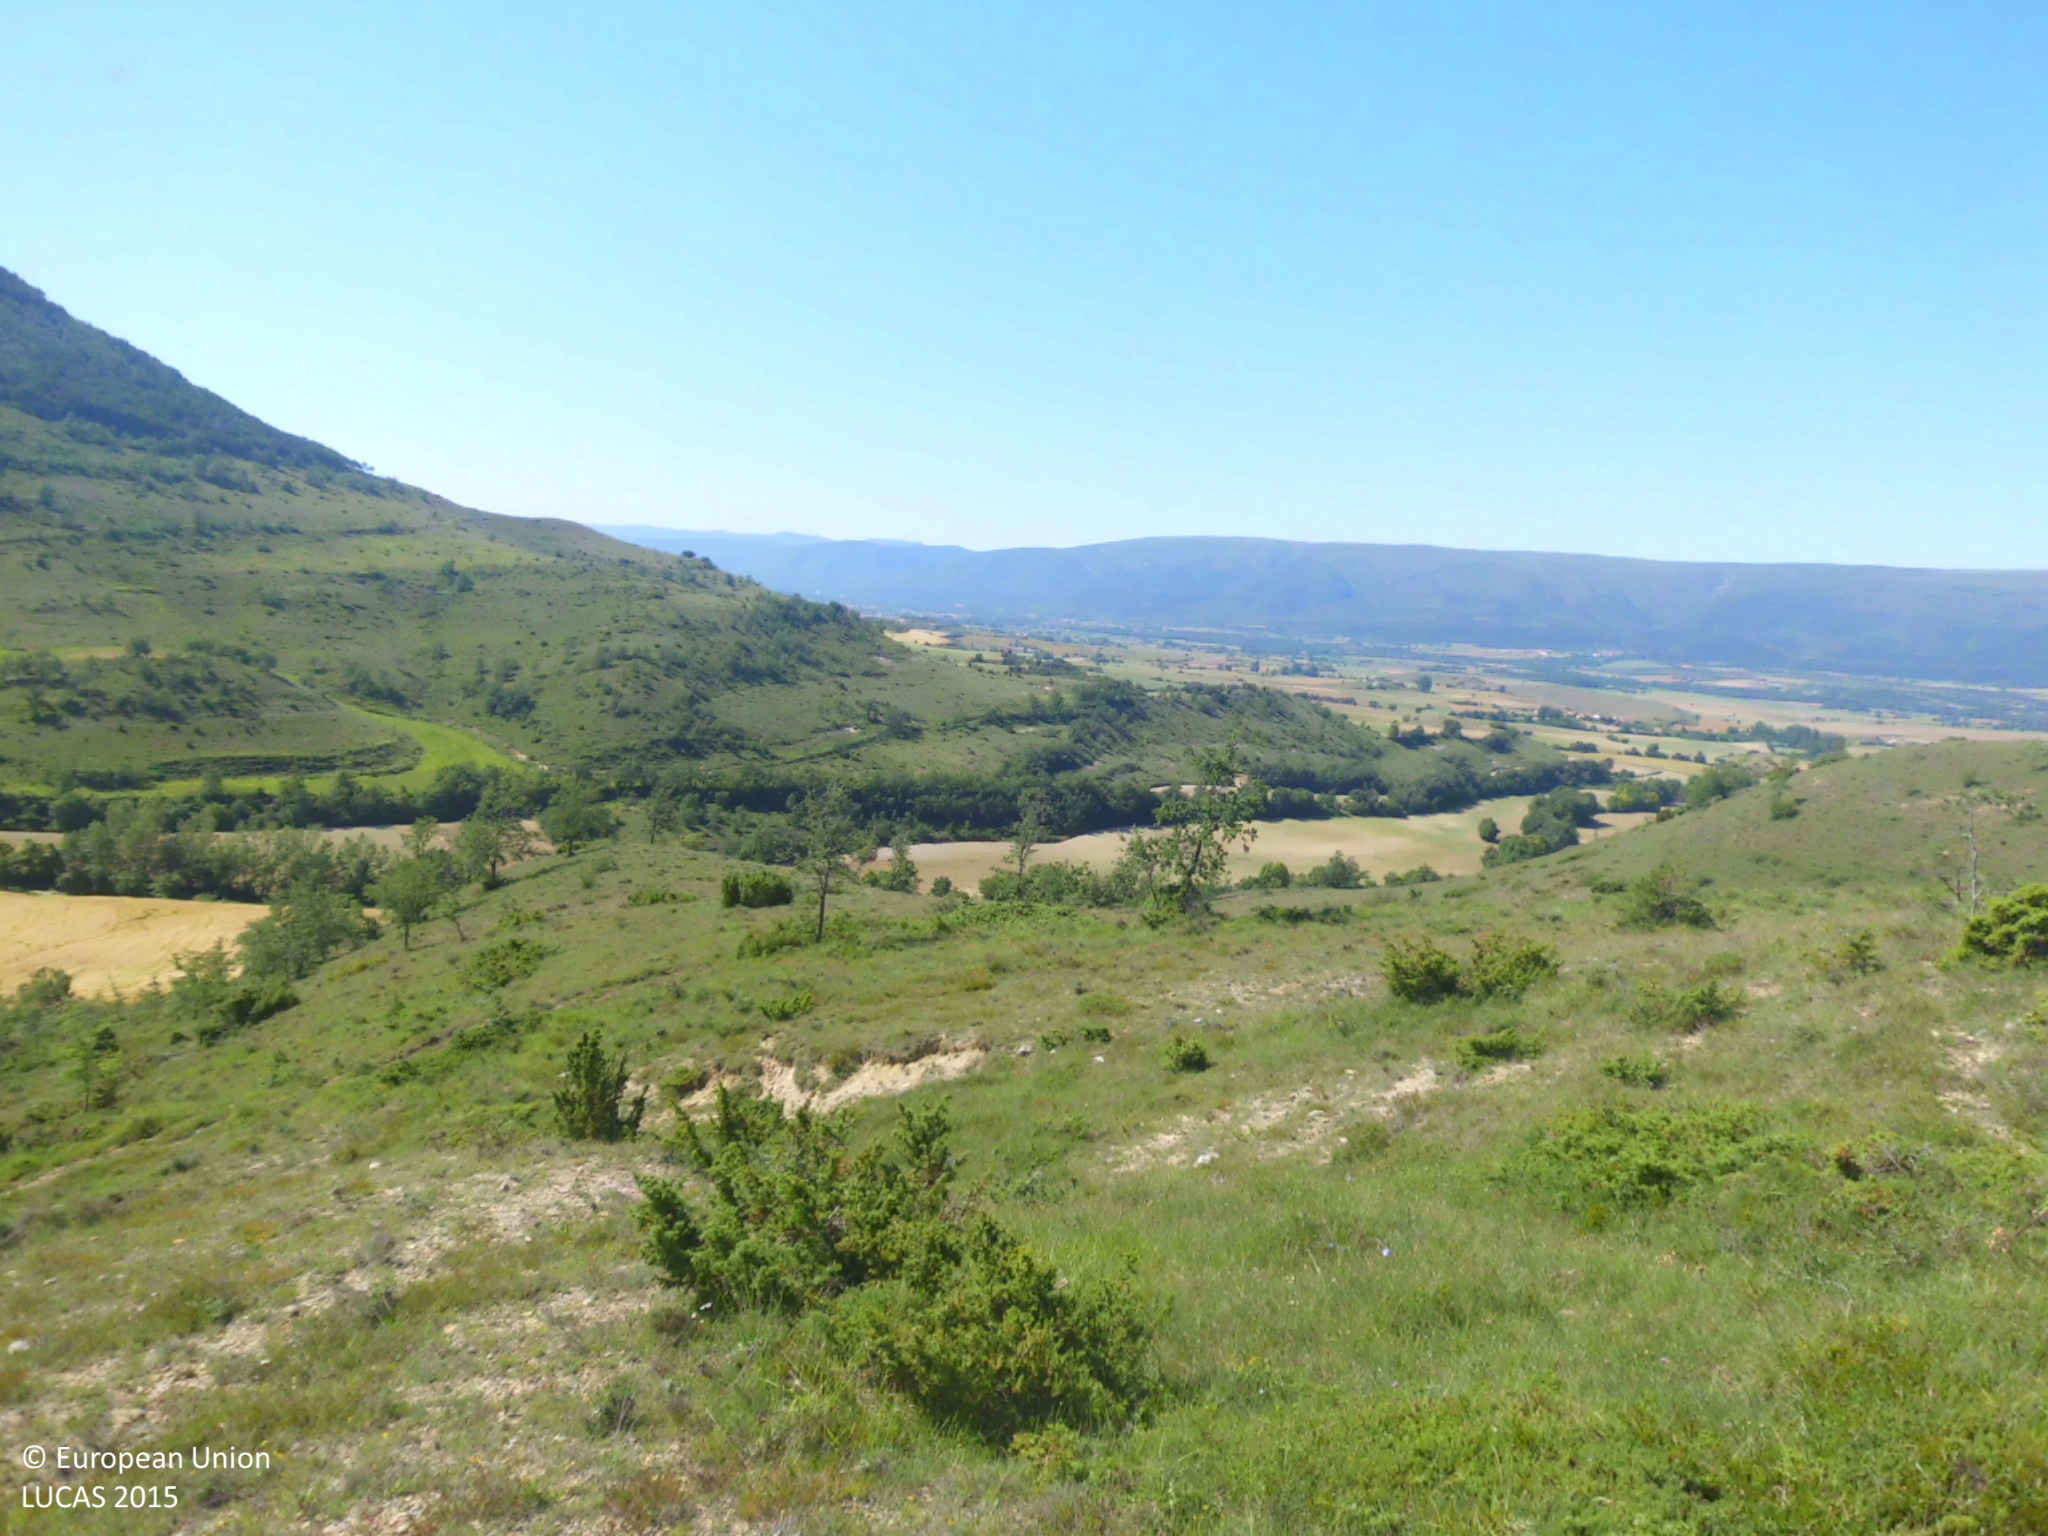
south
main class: Grassland
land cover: Grassland with sparse tree/shrub cover
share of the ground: > 75 %
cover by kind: herbaceous plants 85 %, broadleaved forest trees 5 %, shrubs 5 %, consolidated bare surface 5 %
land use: Agriculture (excluding fallow land and kitchen gardens)
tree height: < 5 m
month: June
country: ES
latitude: 42.9073
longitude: -3.4253
